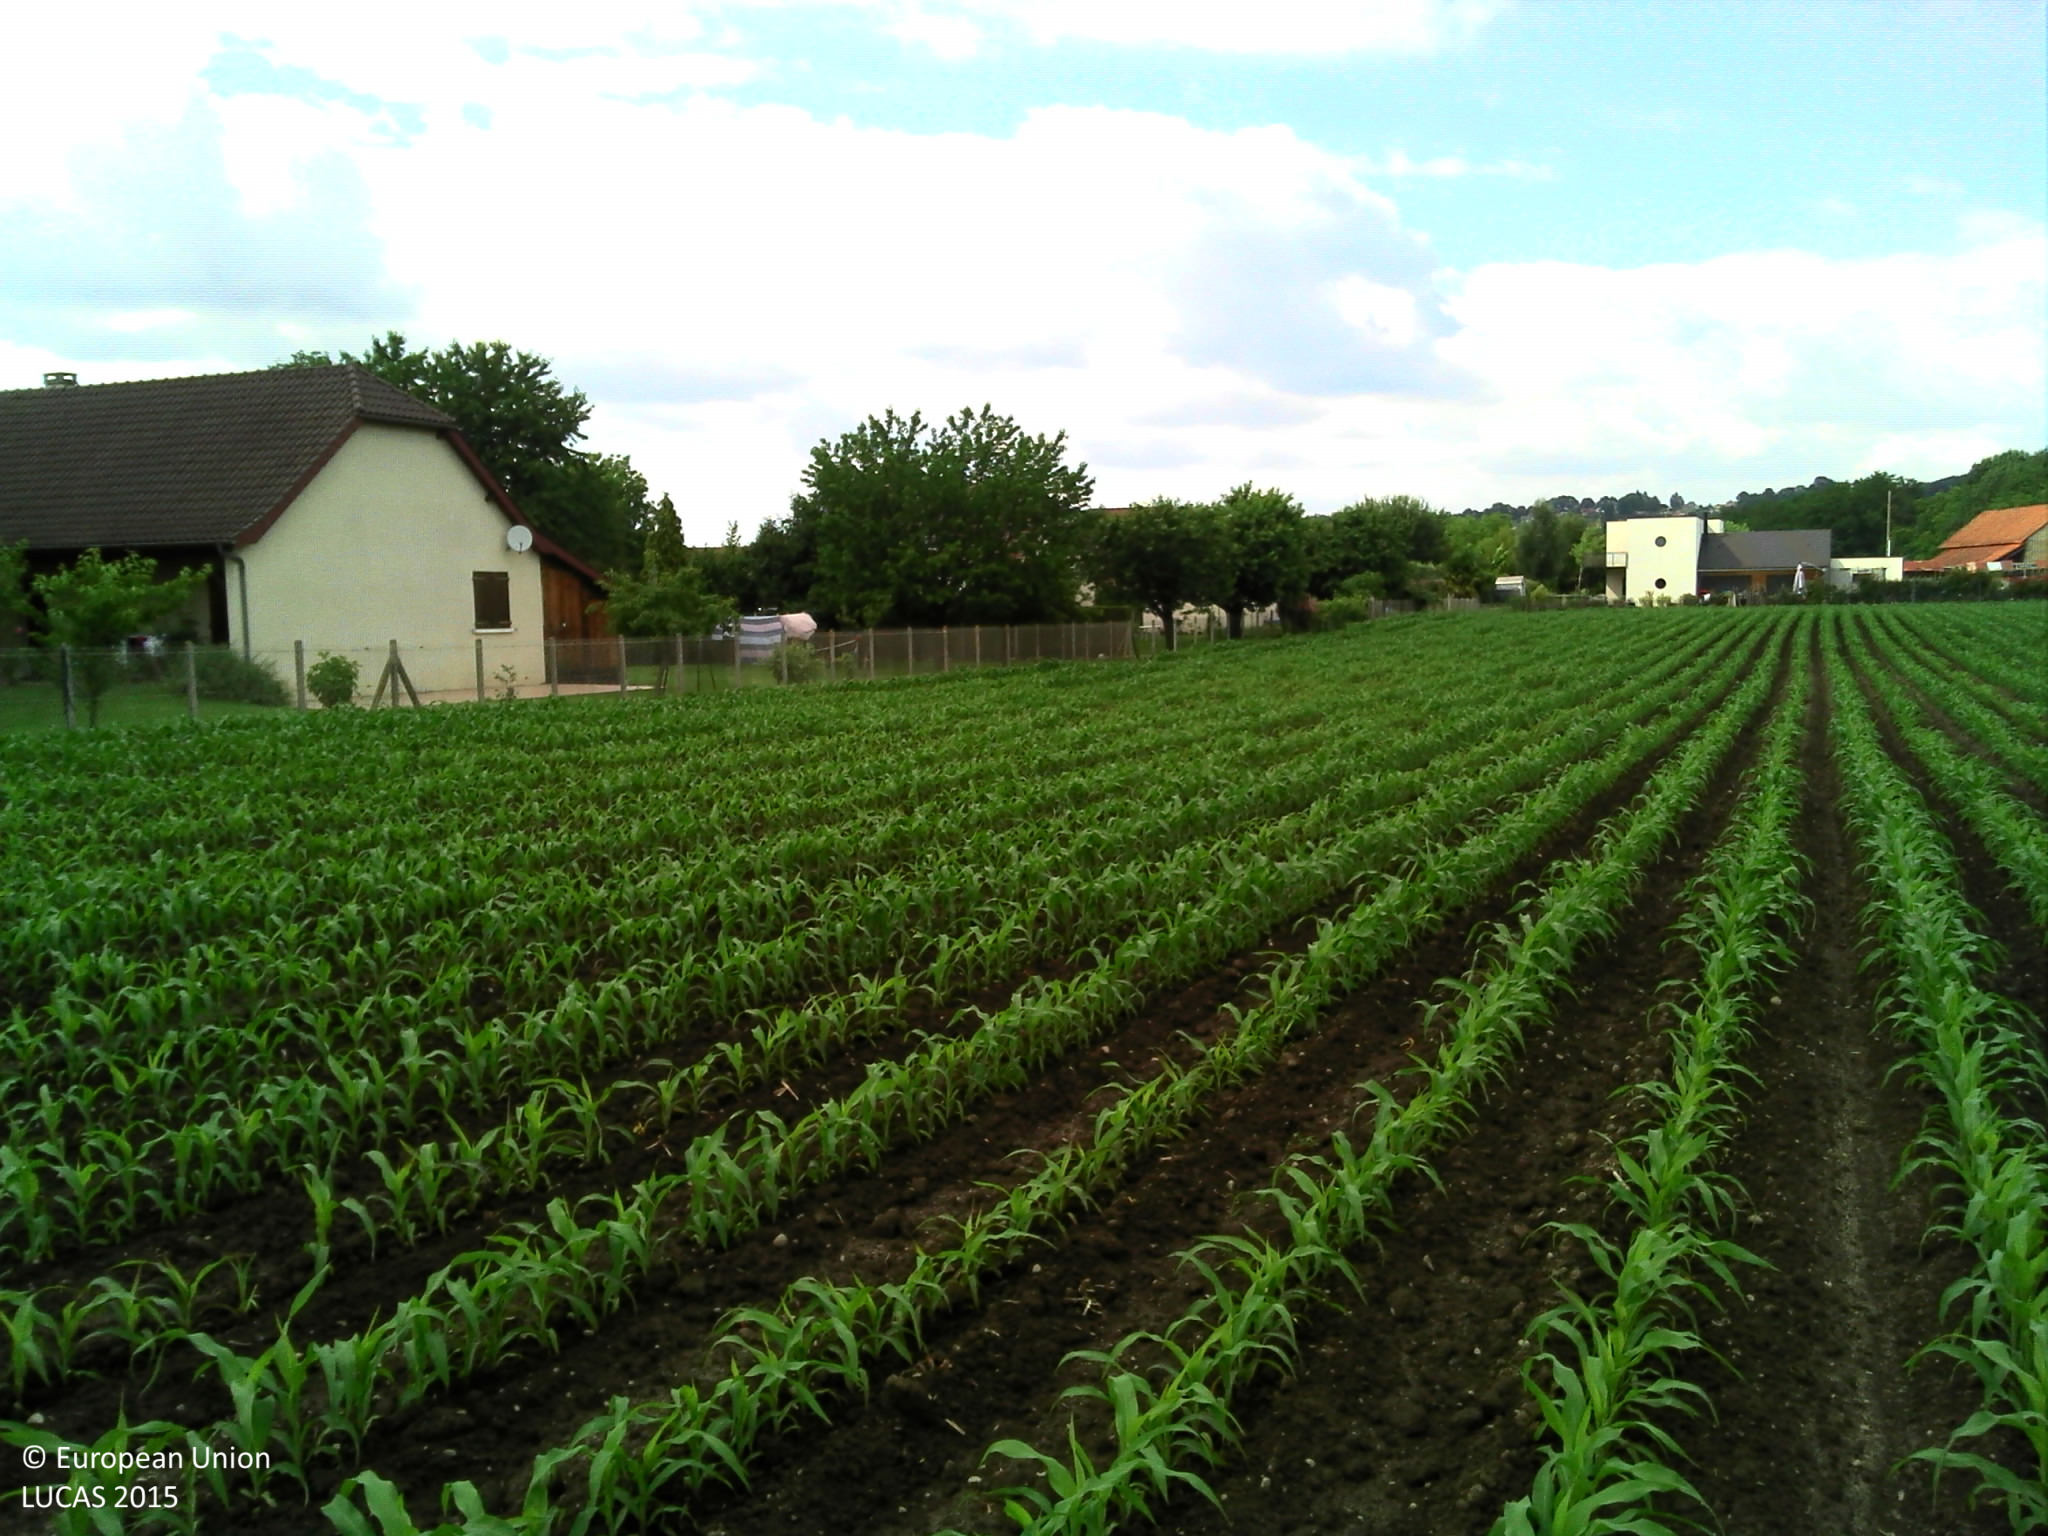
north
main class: Cropland
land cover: Maize
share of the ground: 25 - 50 %
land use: Agriculture (excluding fallow land and kitchen gardens)
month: June
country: FR
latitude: 43.3120
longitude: -0.2764
